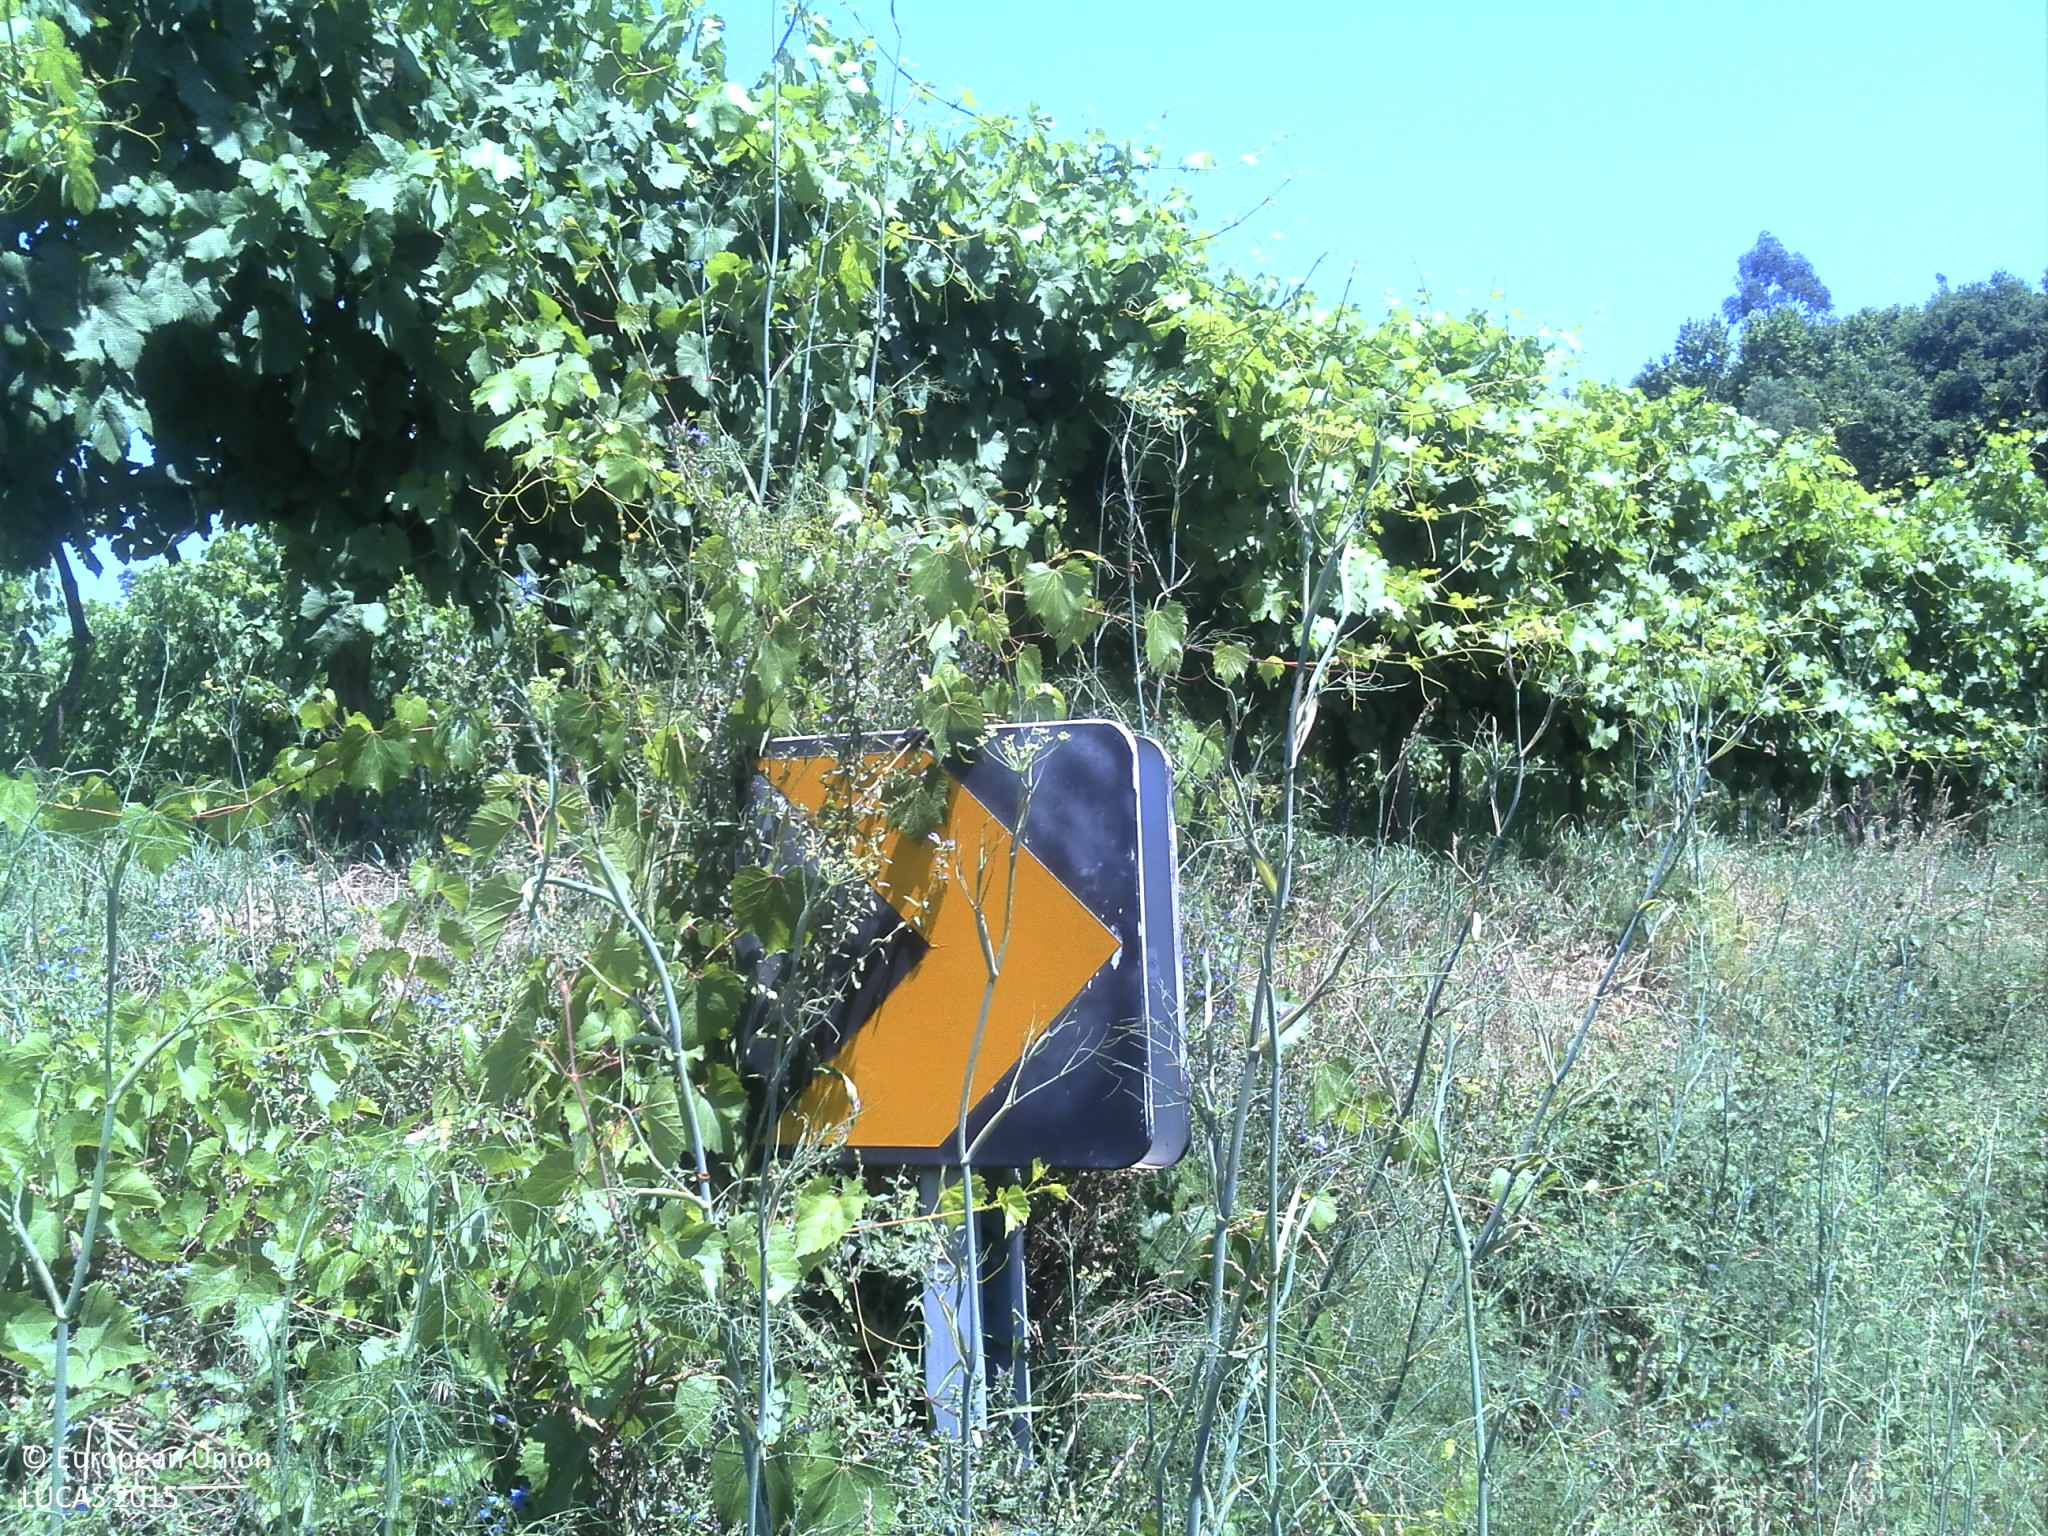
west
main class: Shrubland
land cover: Shrubland without tree cover
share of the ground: > 75 %
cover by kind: shrubs 75 %, consolidated bare surface 15 %, herbaceous plants 10 %
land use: Road transport
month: June
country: PT
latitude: 41.4174
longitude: -7.9776
